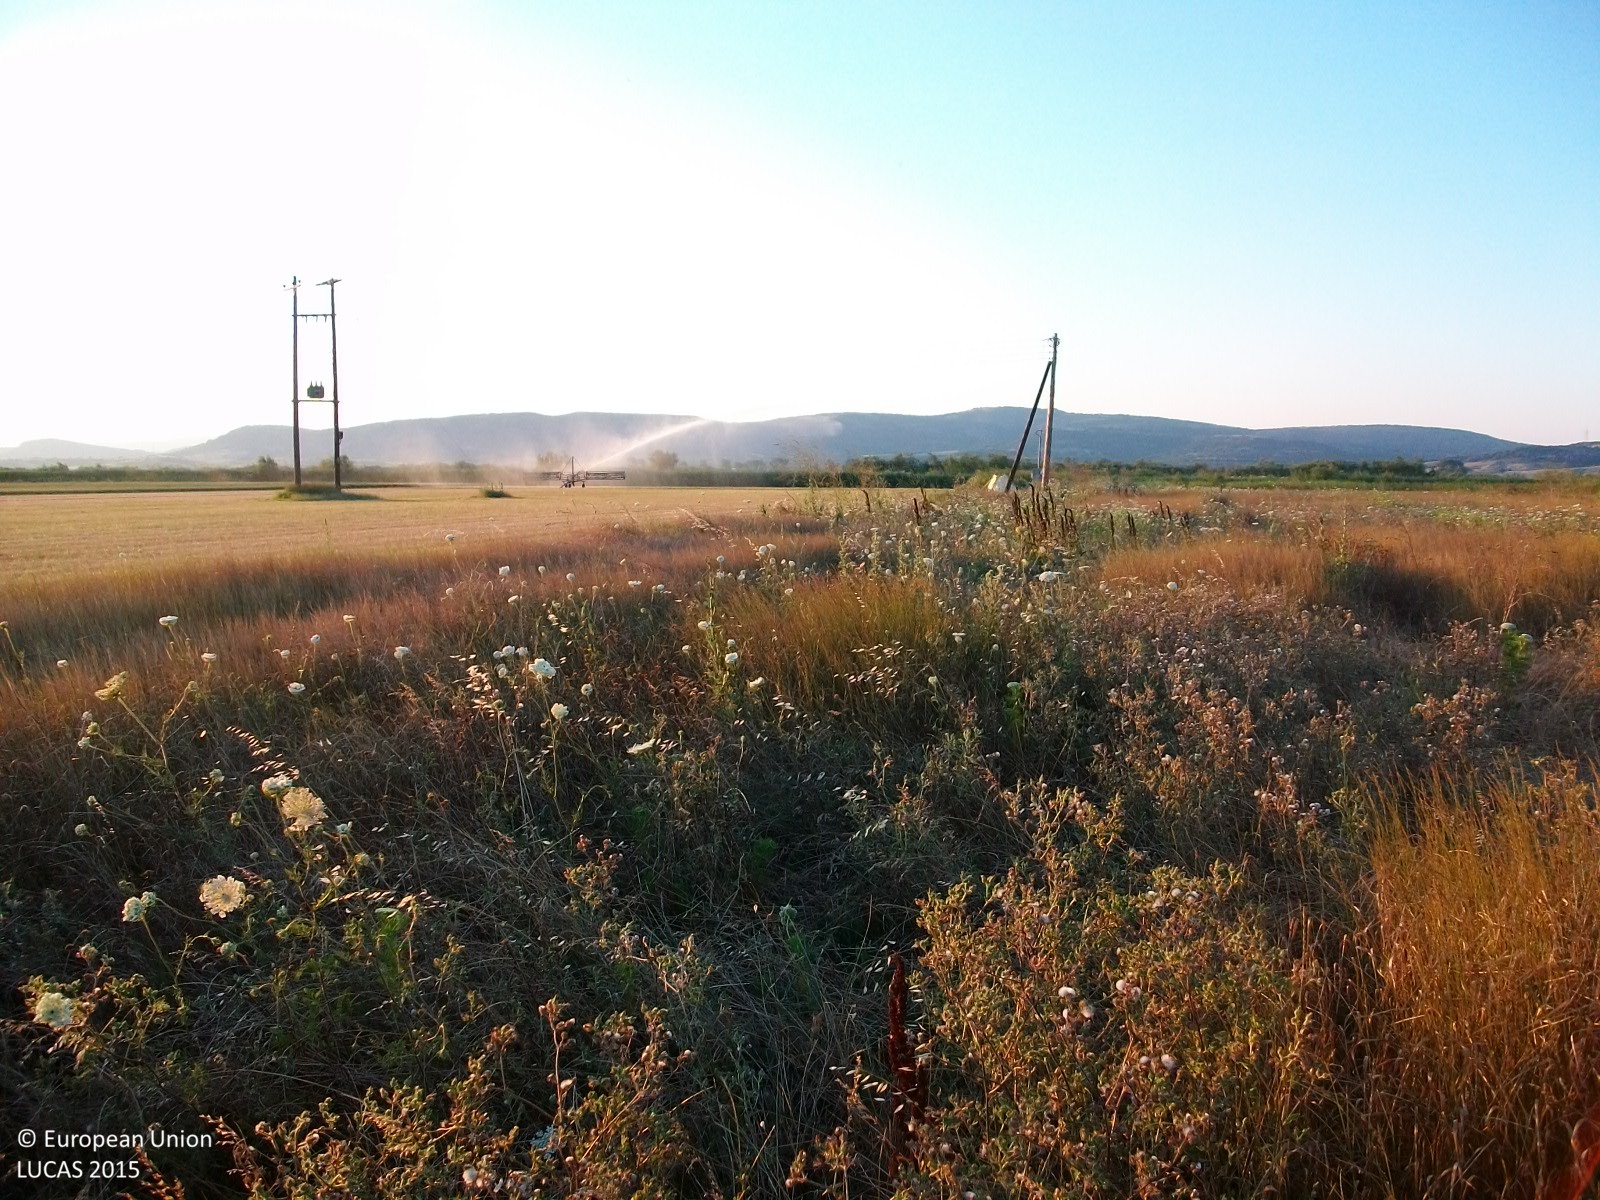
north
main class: Grassland
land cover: Spontaneously vegetated surfaces
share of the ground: > 75 %
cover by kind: herbaceous plants 100 %
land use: Fallow land
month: July
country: GR
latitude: 40.8264
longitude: 26.0793
